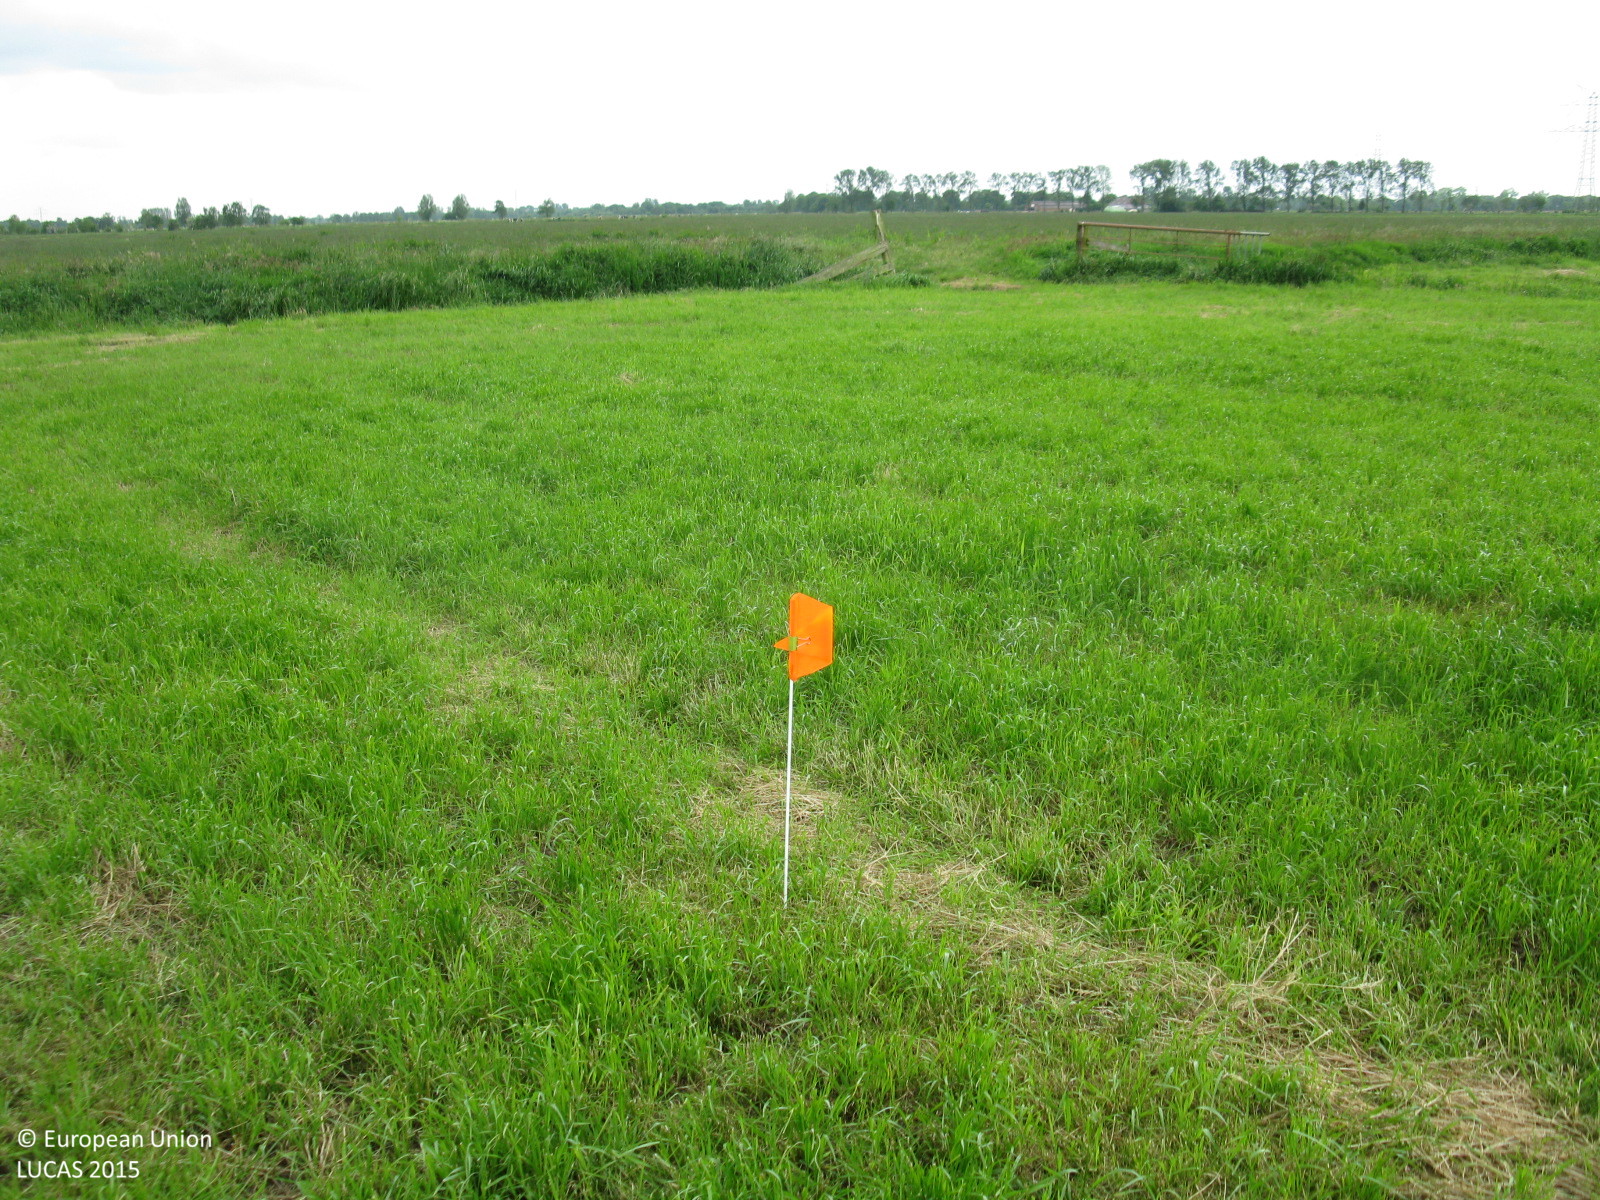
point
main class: Grassland
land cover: Grassland without tree/shrub cover
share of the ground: > 75 %
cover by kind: herbaceous plants 100 %
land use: Agriculture (excluding fallow land and kitchen gardens)
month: June
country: DE
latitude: 53.1393
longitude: 7.3546
